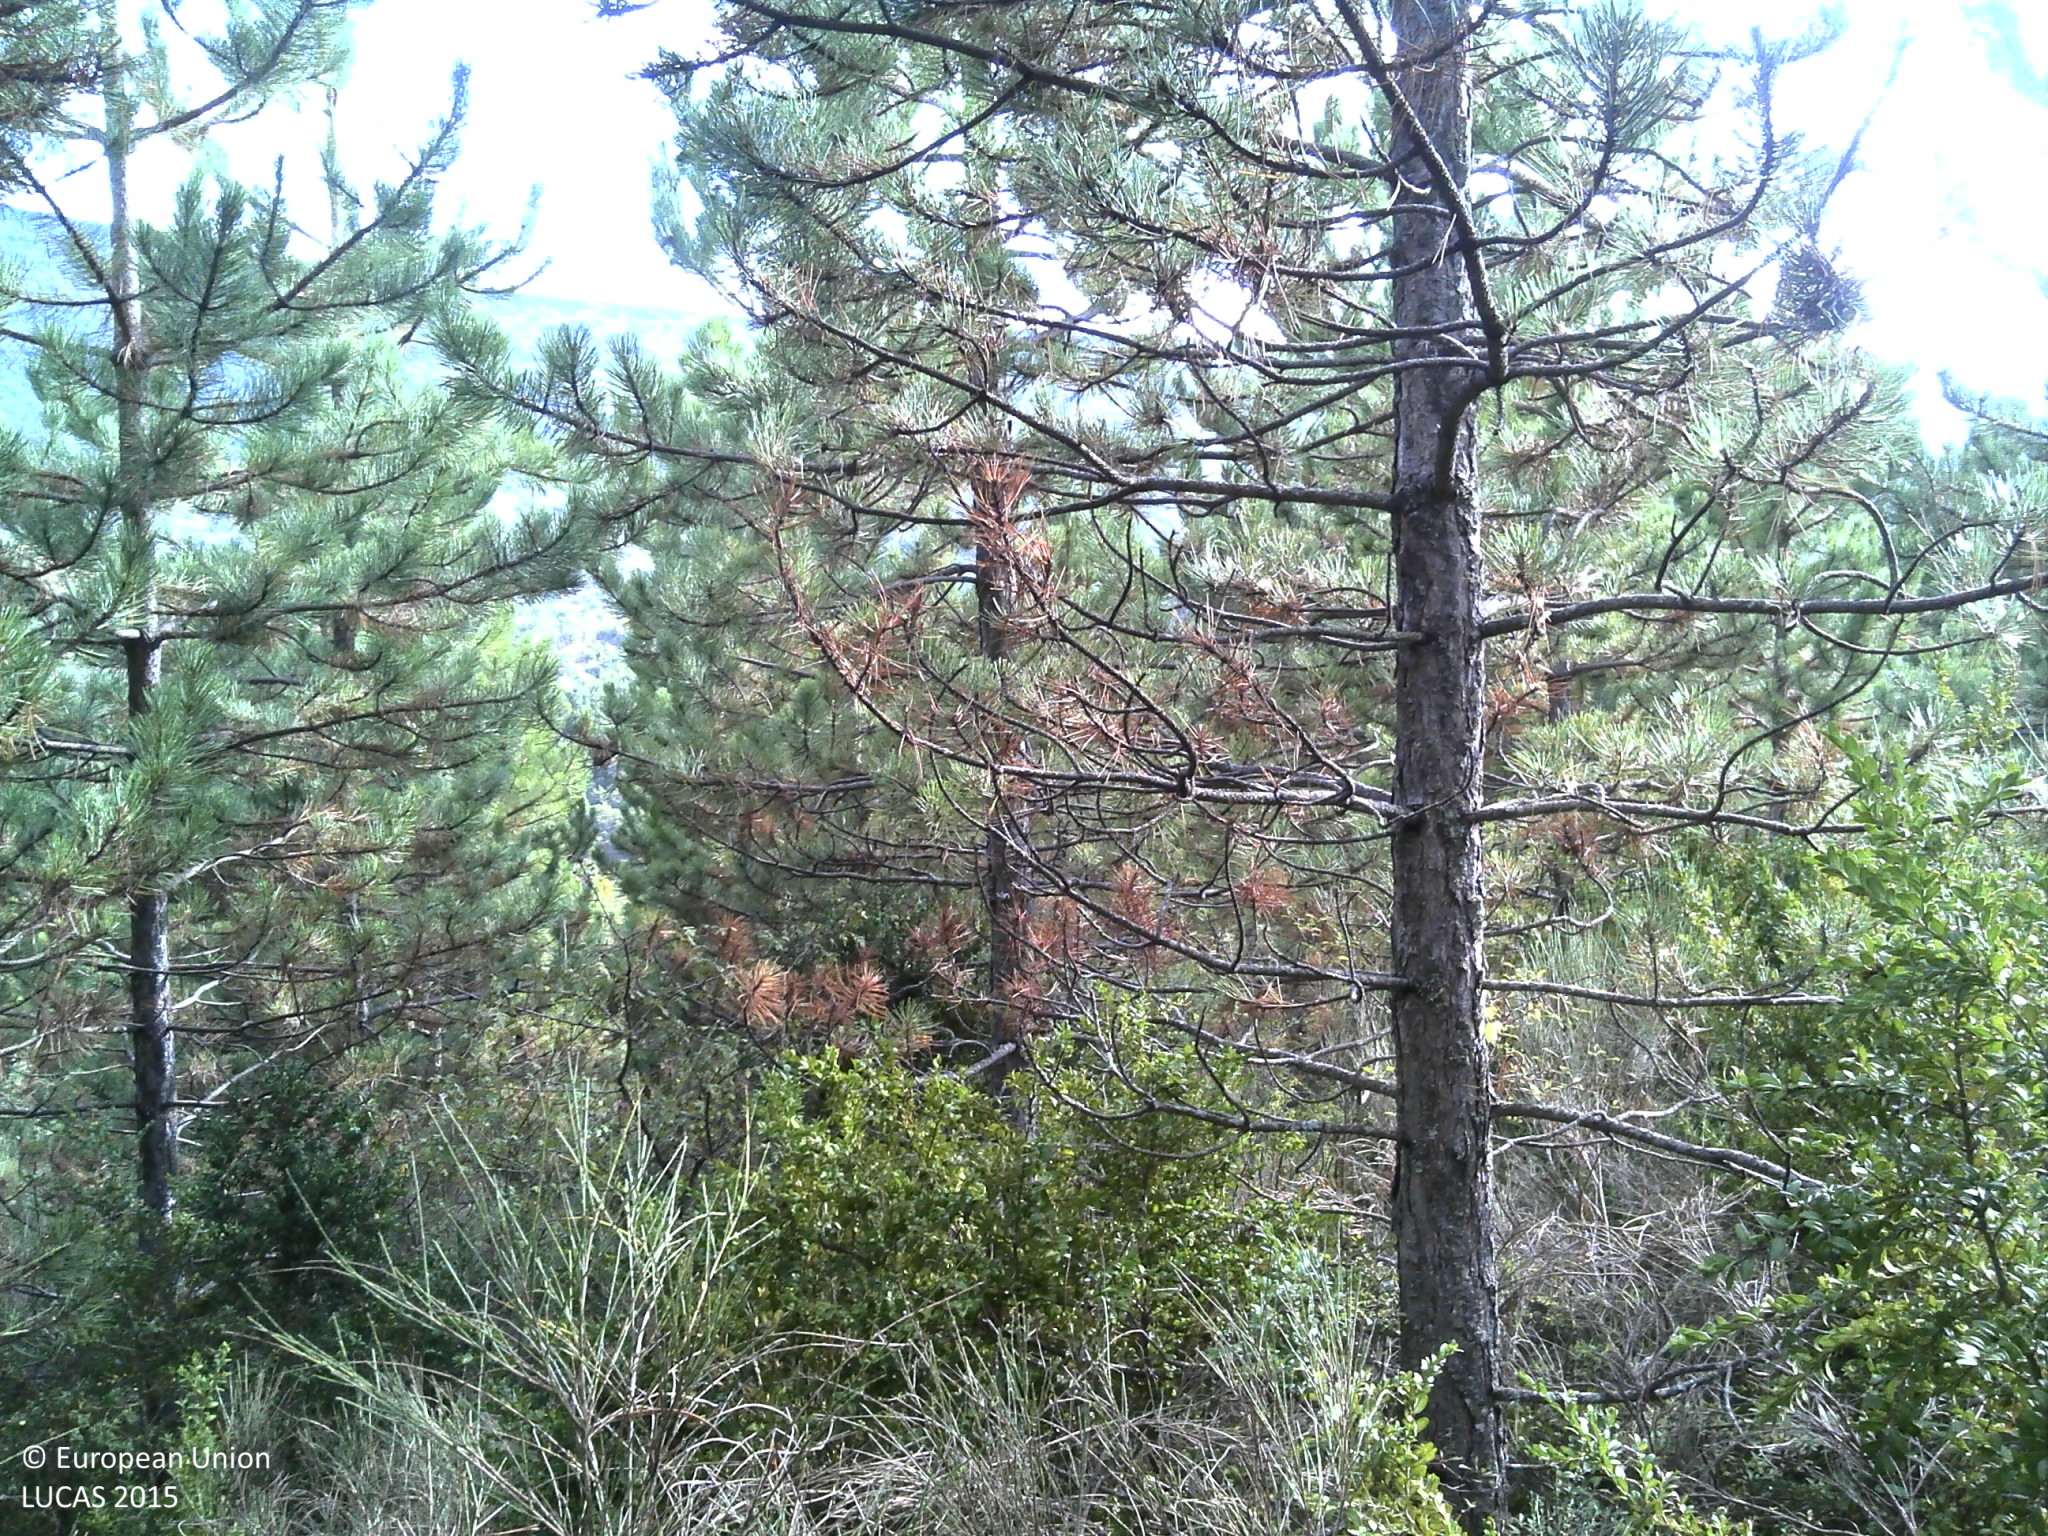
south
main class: Woodland
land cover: Pine dominated coniferous woodland
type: alpine coniferous forest
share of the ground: > 75 %
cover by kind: coniferous forest trees 70 %, shrubs 20 %, herbaceous plants 10 %
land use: Forestry
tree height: > 5 m
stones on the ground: < 10 %
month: September
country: FR
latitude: 43.7710
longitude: 6.5914
